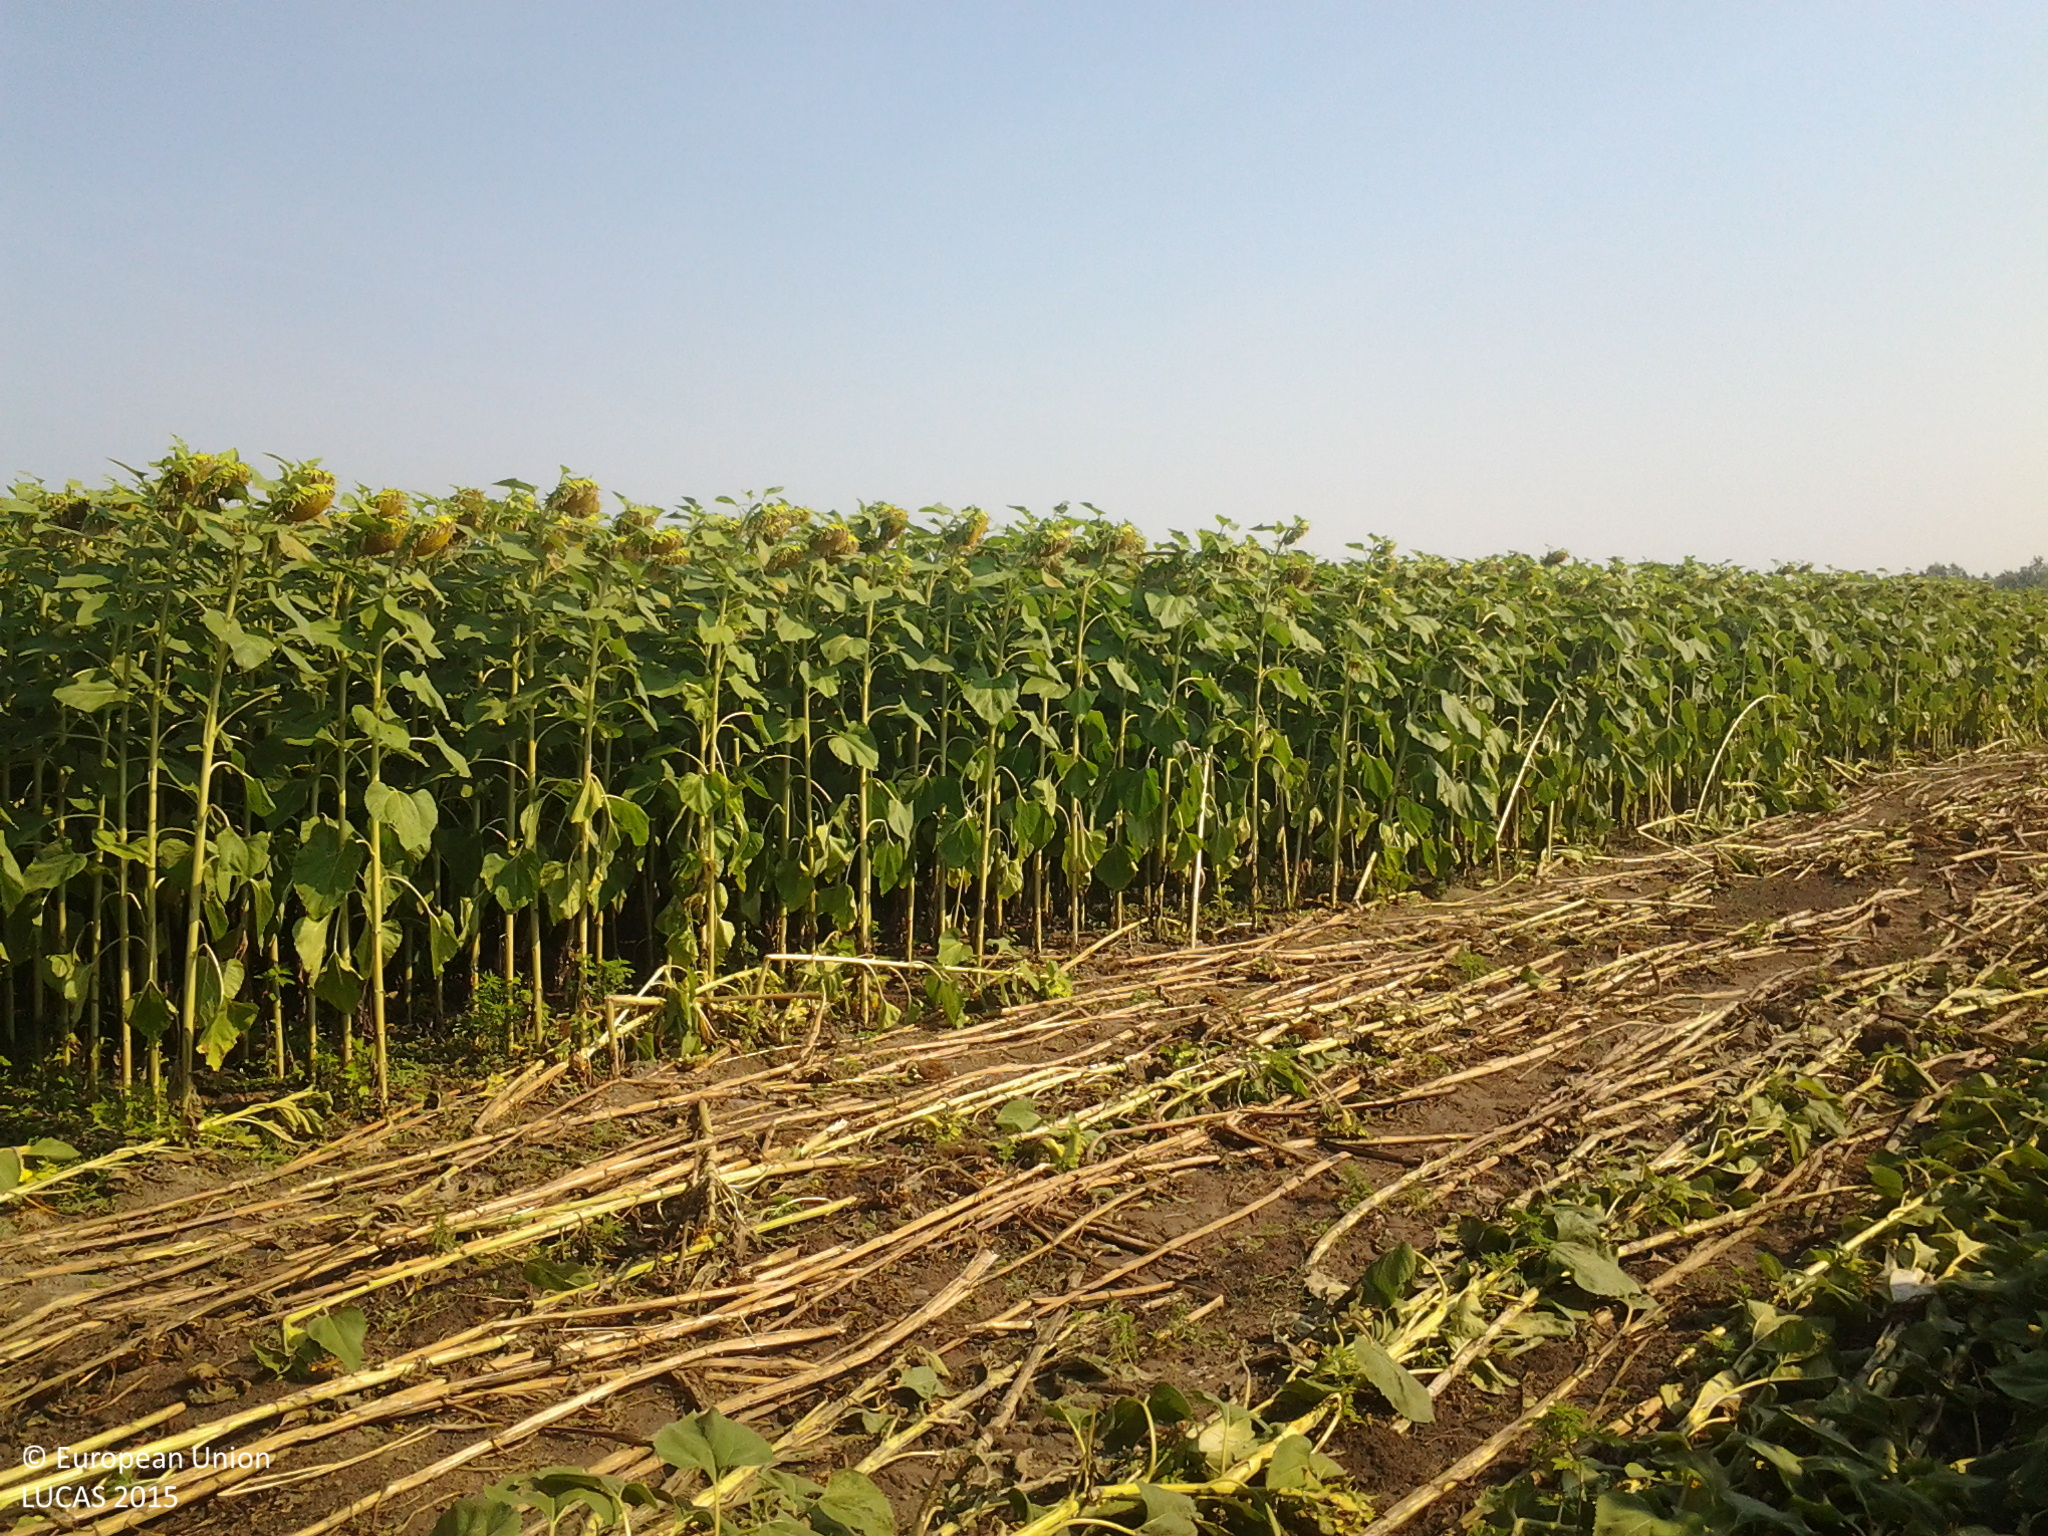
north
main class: Cropland
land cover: Sunflower
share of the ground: > 75 %
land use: Agriculture (excluding fallow land and kitchen gardens)
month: July
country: HU
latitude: 46.8188
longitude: 19.0459
